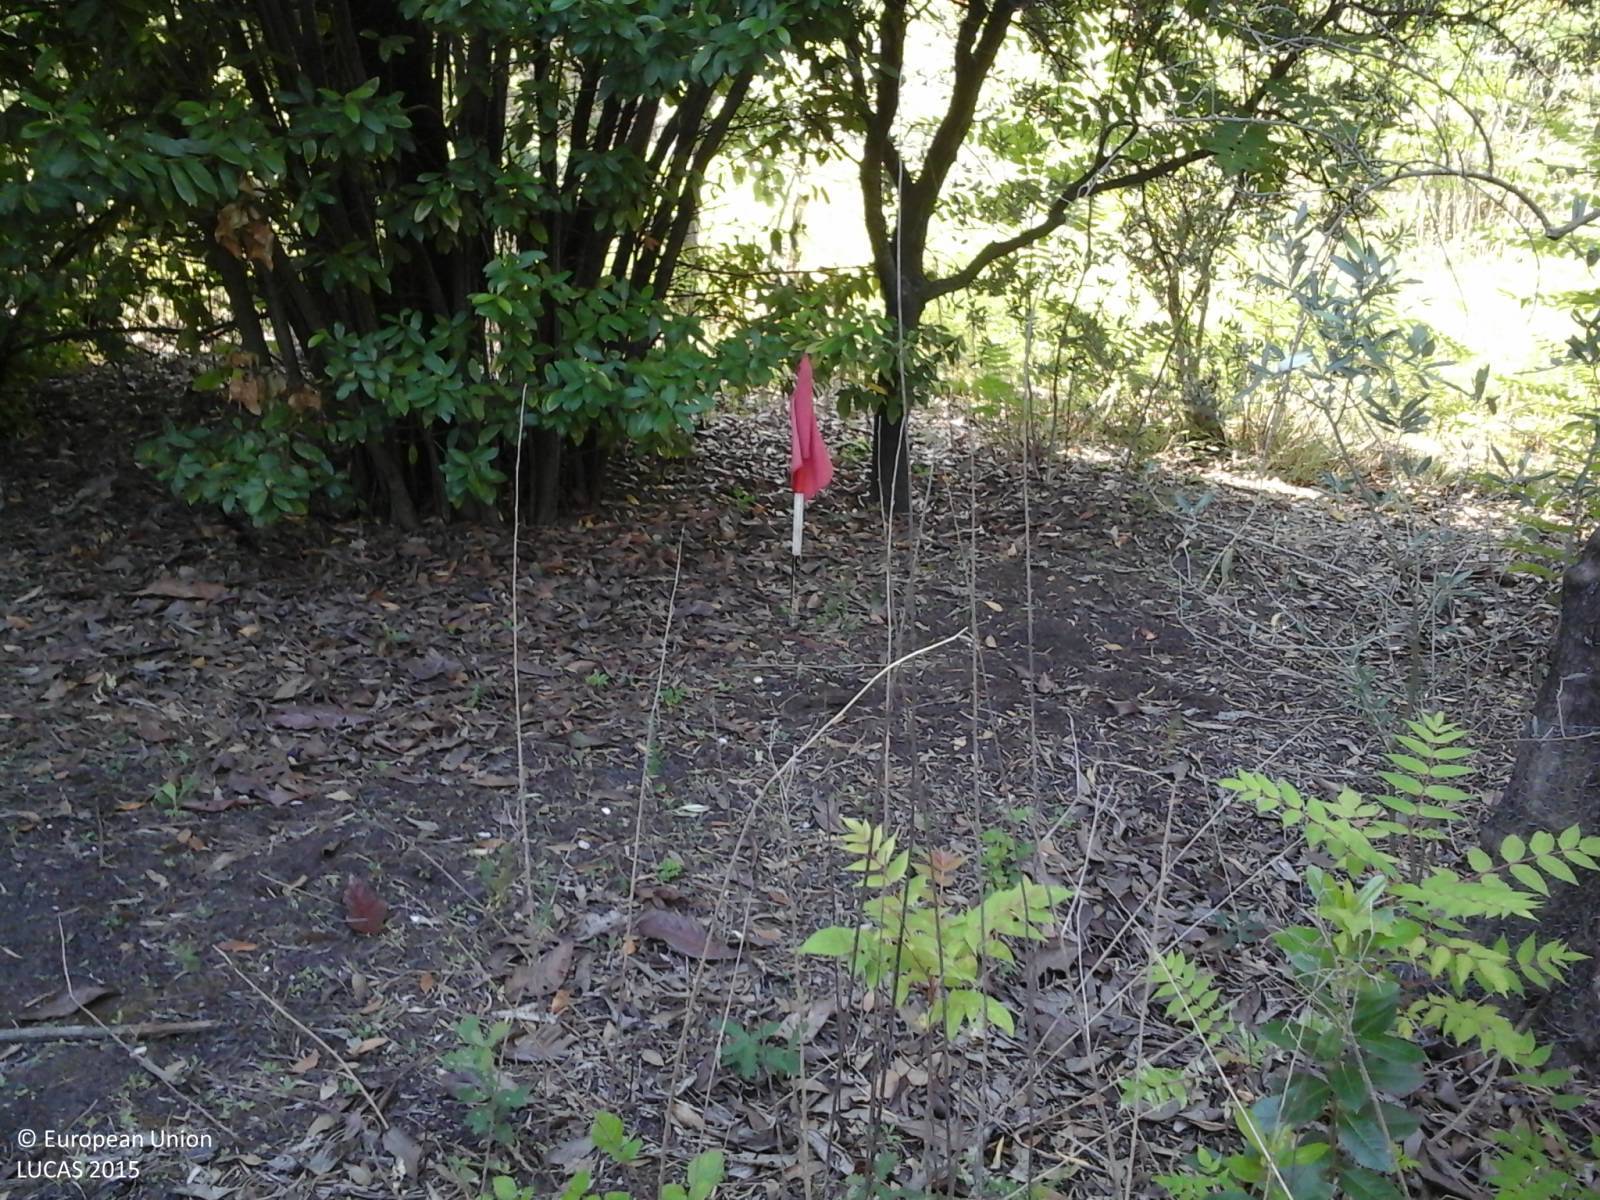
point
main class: Woodland
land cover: Broadleaved woodland
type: broadleaved evergreen forest
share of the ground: > 75 %
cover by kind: broadleaved forest trees 100 %
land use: Semi-natural and natural areas not in use
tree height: < 5 m
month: June
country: IT
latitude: 40.7825
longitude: 14.4487
